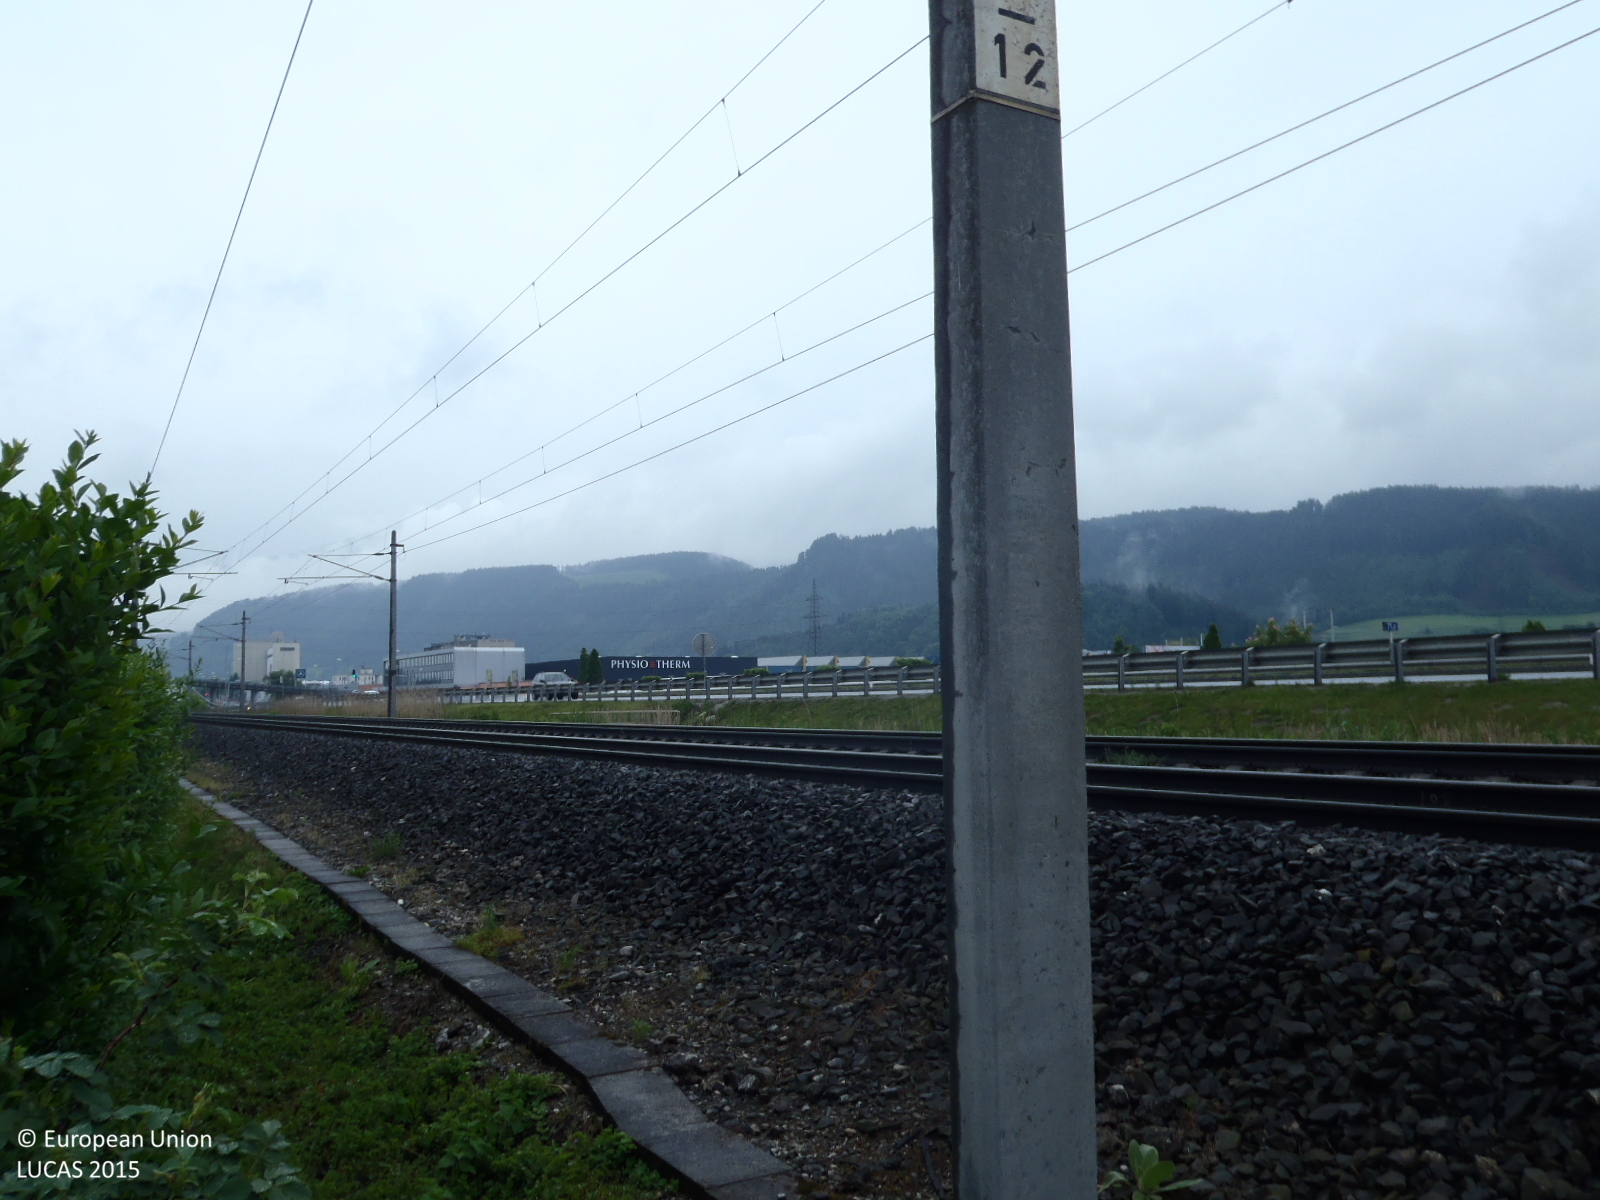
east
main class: Woodland
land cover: Broadleaved woodland
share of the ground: > 75 %
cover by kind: broadleaved forest trees 95 %, shrubs 5 %
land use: Residential
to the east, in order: Broadleaved woodland; Artificial constructions in urban areas; Temporary grasslands; Artificial constructions in urban areas; Other fresh vegetables; Tracks; Other root crops
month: May
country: AT
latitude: 47.2777
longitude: 11.4661
